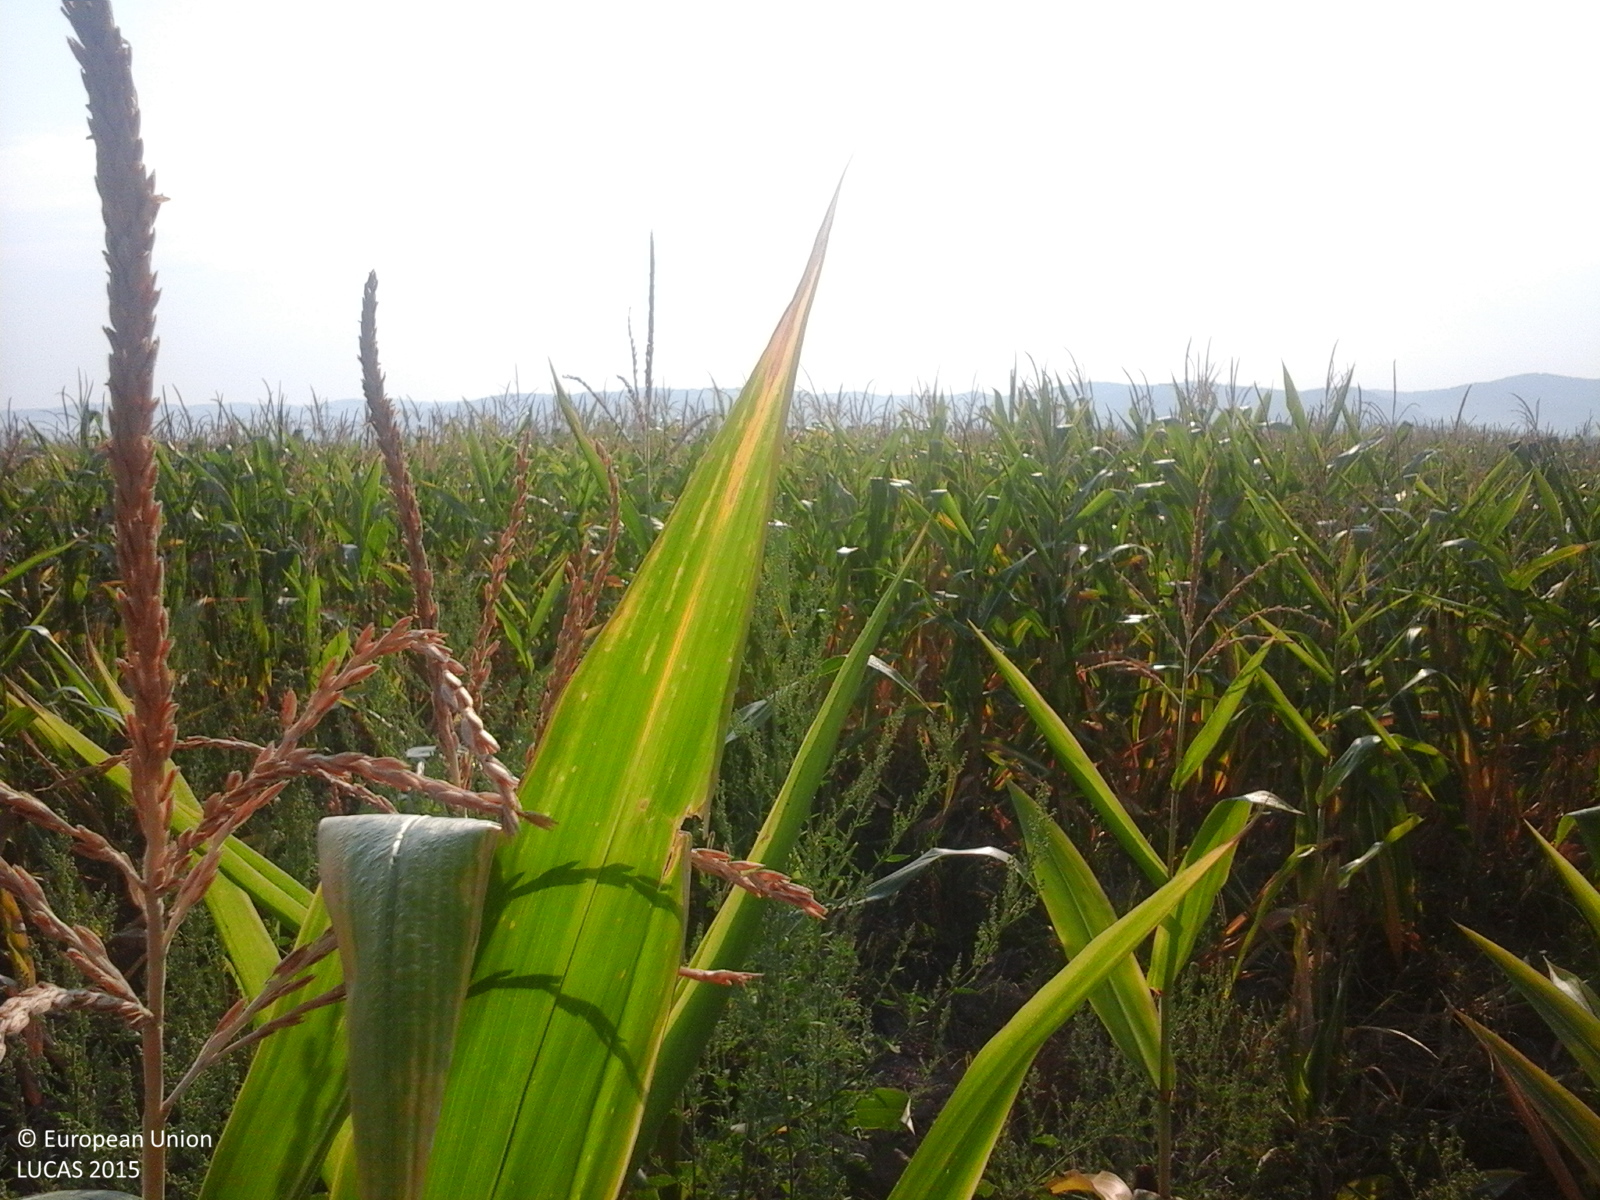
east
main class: Cropland
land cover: Maize
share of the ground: > 75 %
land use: Agriculture (excluding fallow land and kitchen gardens)
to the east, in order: Maize; Barley; Maize; Barley; Spontaneously vegetated surfaces; Maize; Common wheat
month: August
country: RO
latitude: 44.7624
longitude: 23.4849
